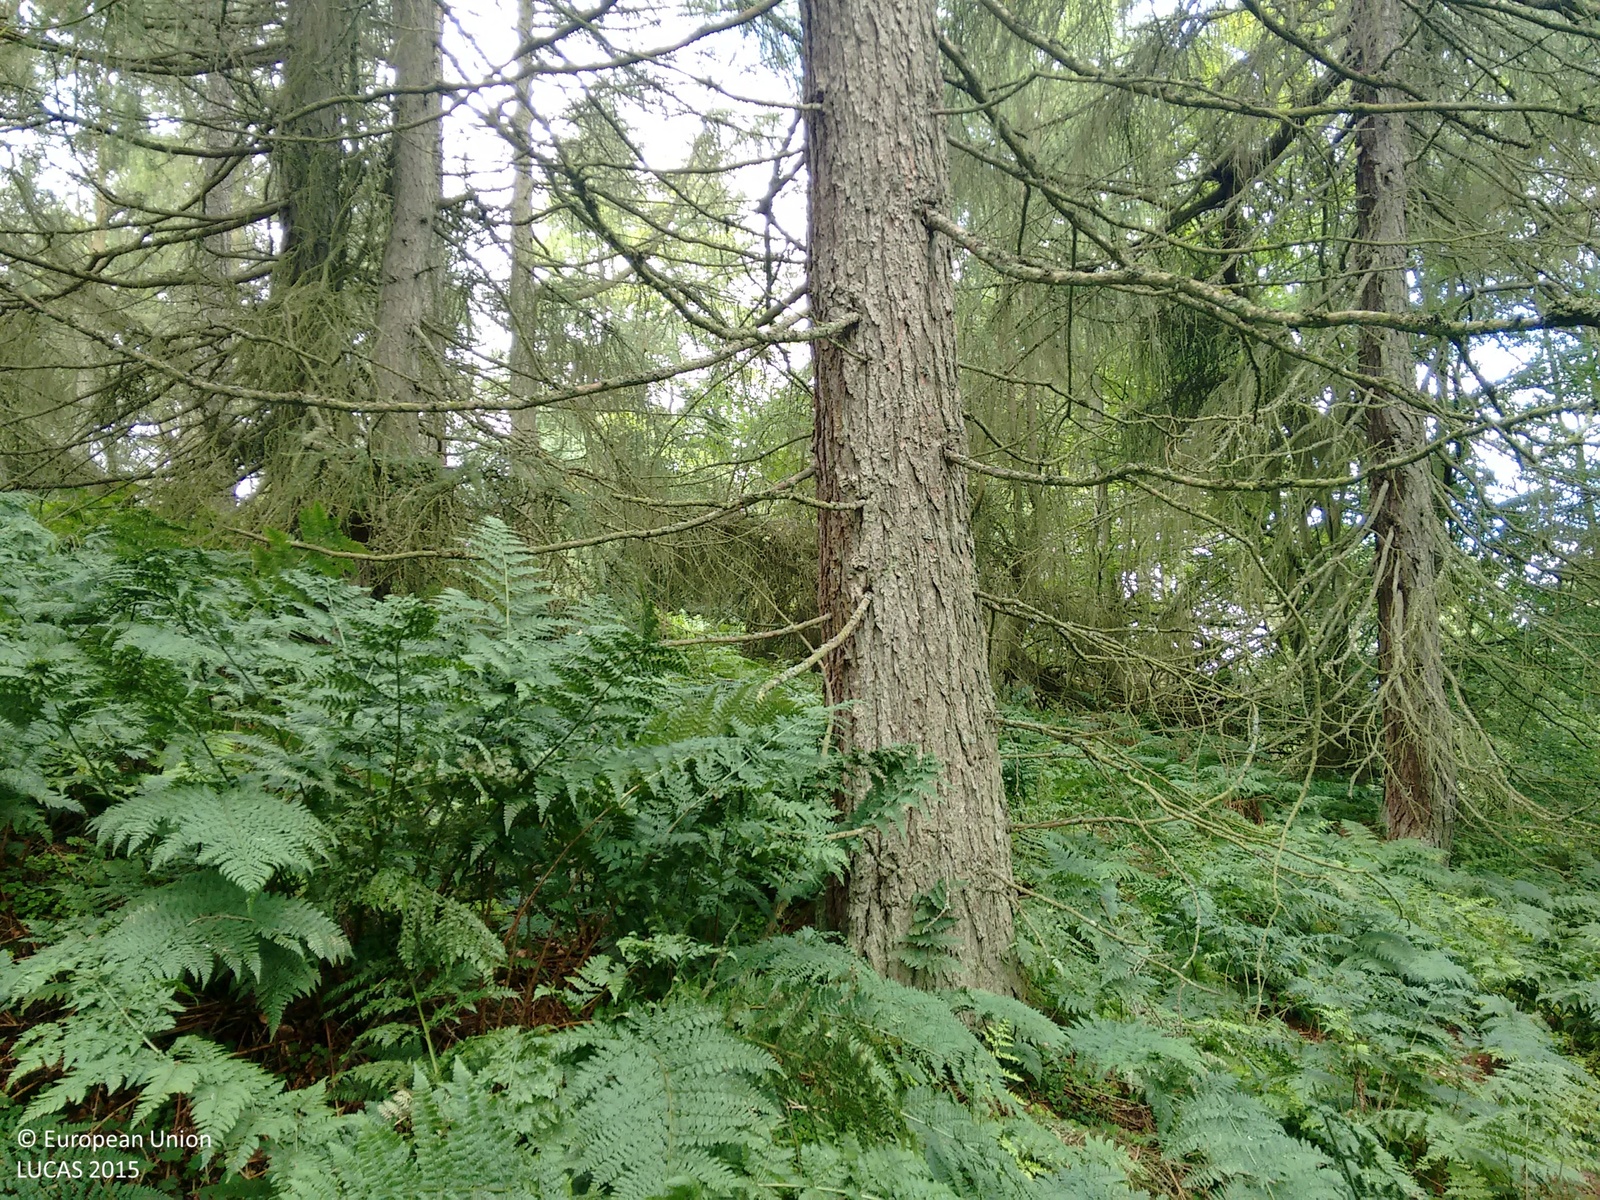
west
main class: Woodland
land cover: Other mixed woodland
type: acidophilous oak and oak-birch forest
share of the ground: > 75 %
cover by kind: coniferous forest trees 60 %, broadleaved forest trees 35 %, herbaceous plants 5 %
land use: Forestry
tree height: > 5 m
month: July
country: GB
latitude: 56.3860
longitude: -2.9416
